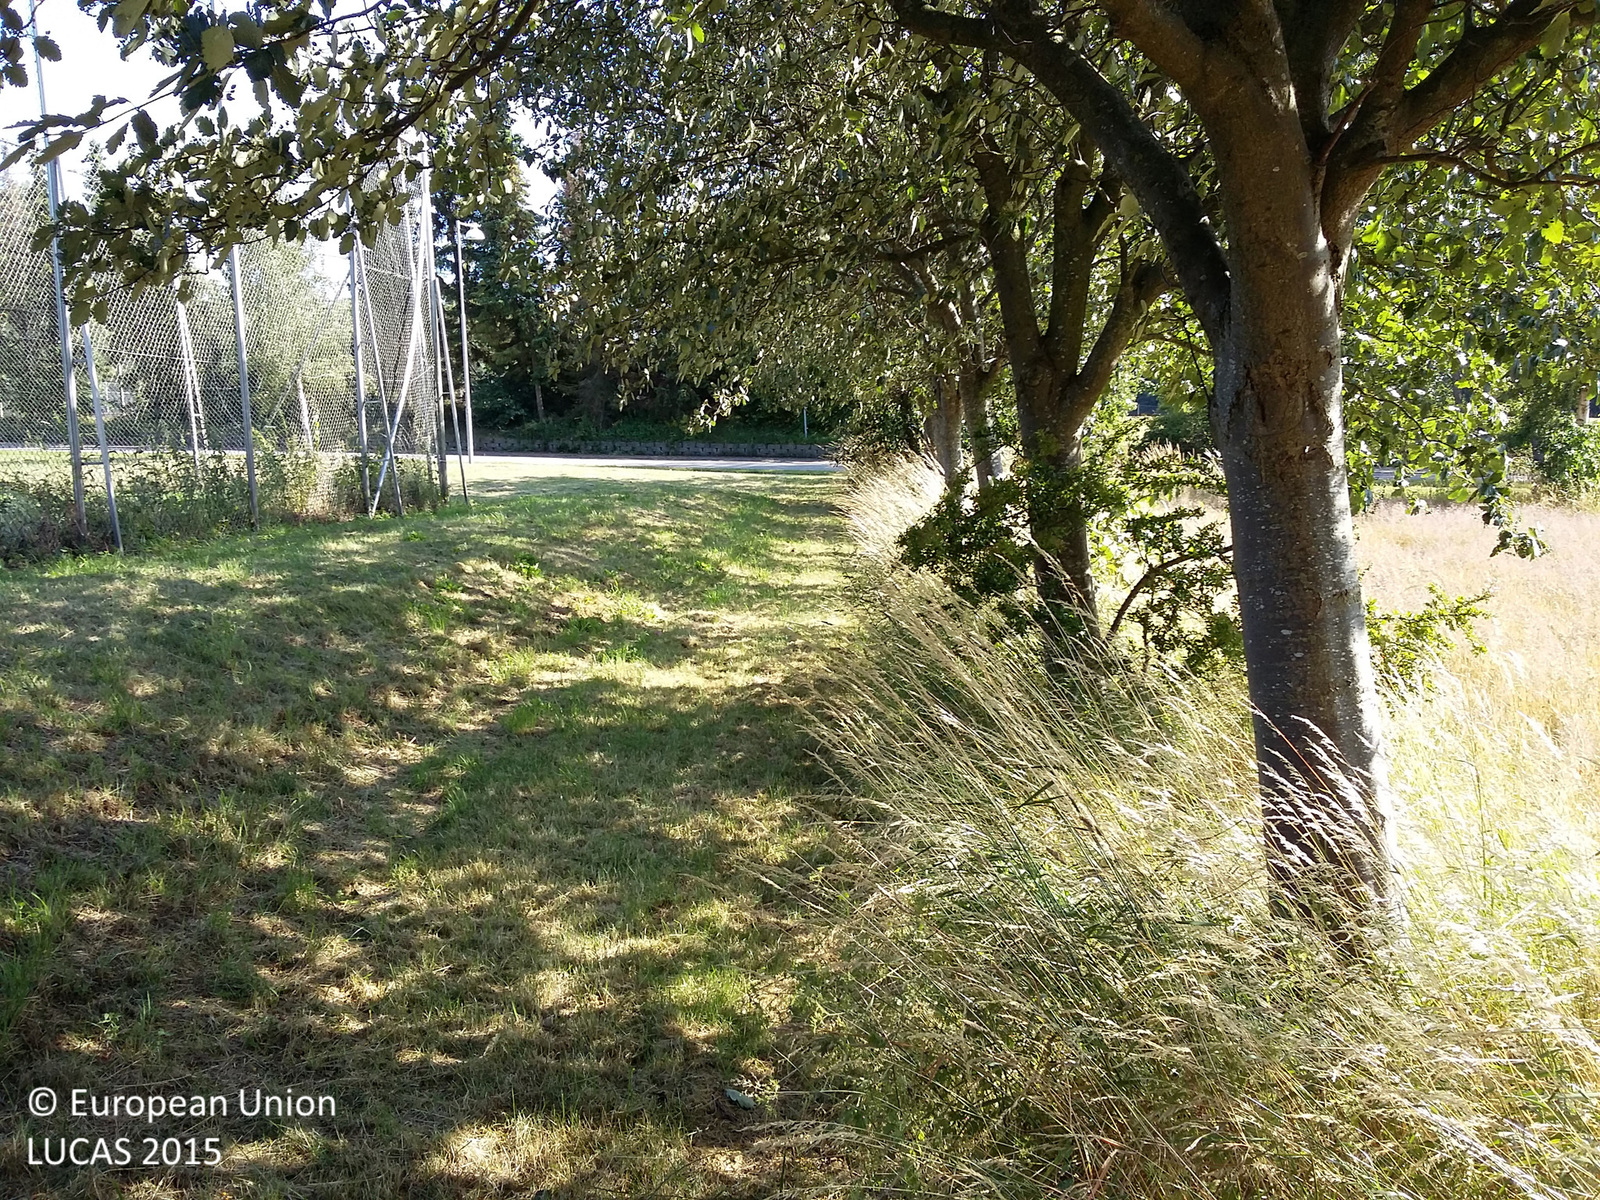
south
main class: Grassland
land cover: Grassland without tree/shrub cover
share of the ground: > 75 %
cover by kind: herbaceous plants 100 %
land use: Sport
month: July
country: DK
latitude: 55.9079
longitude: 11.6140
